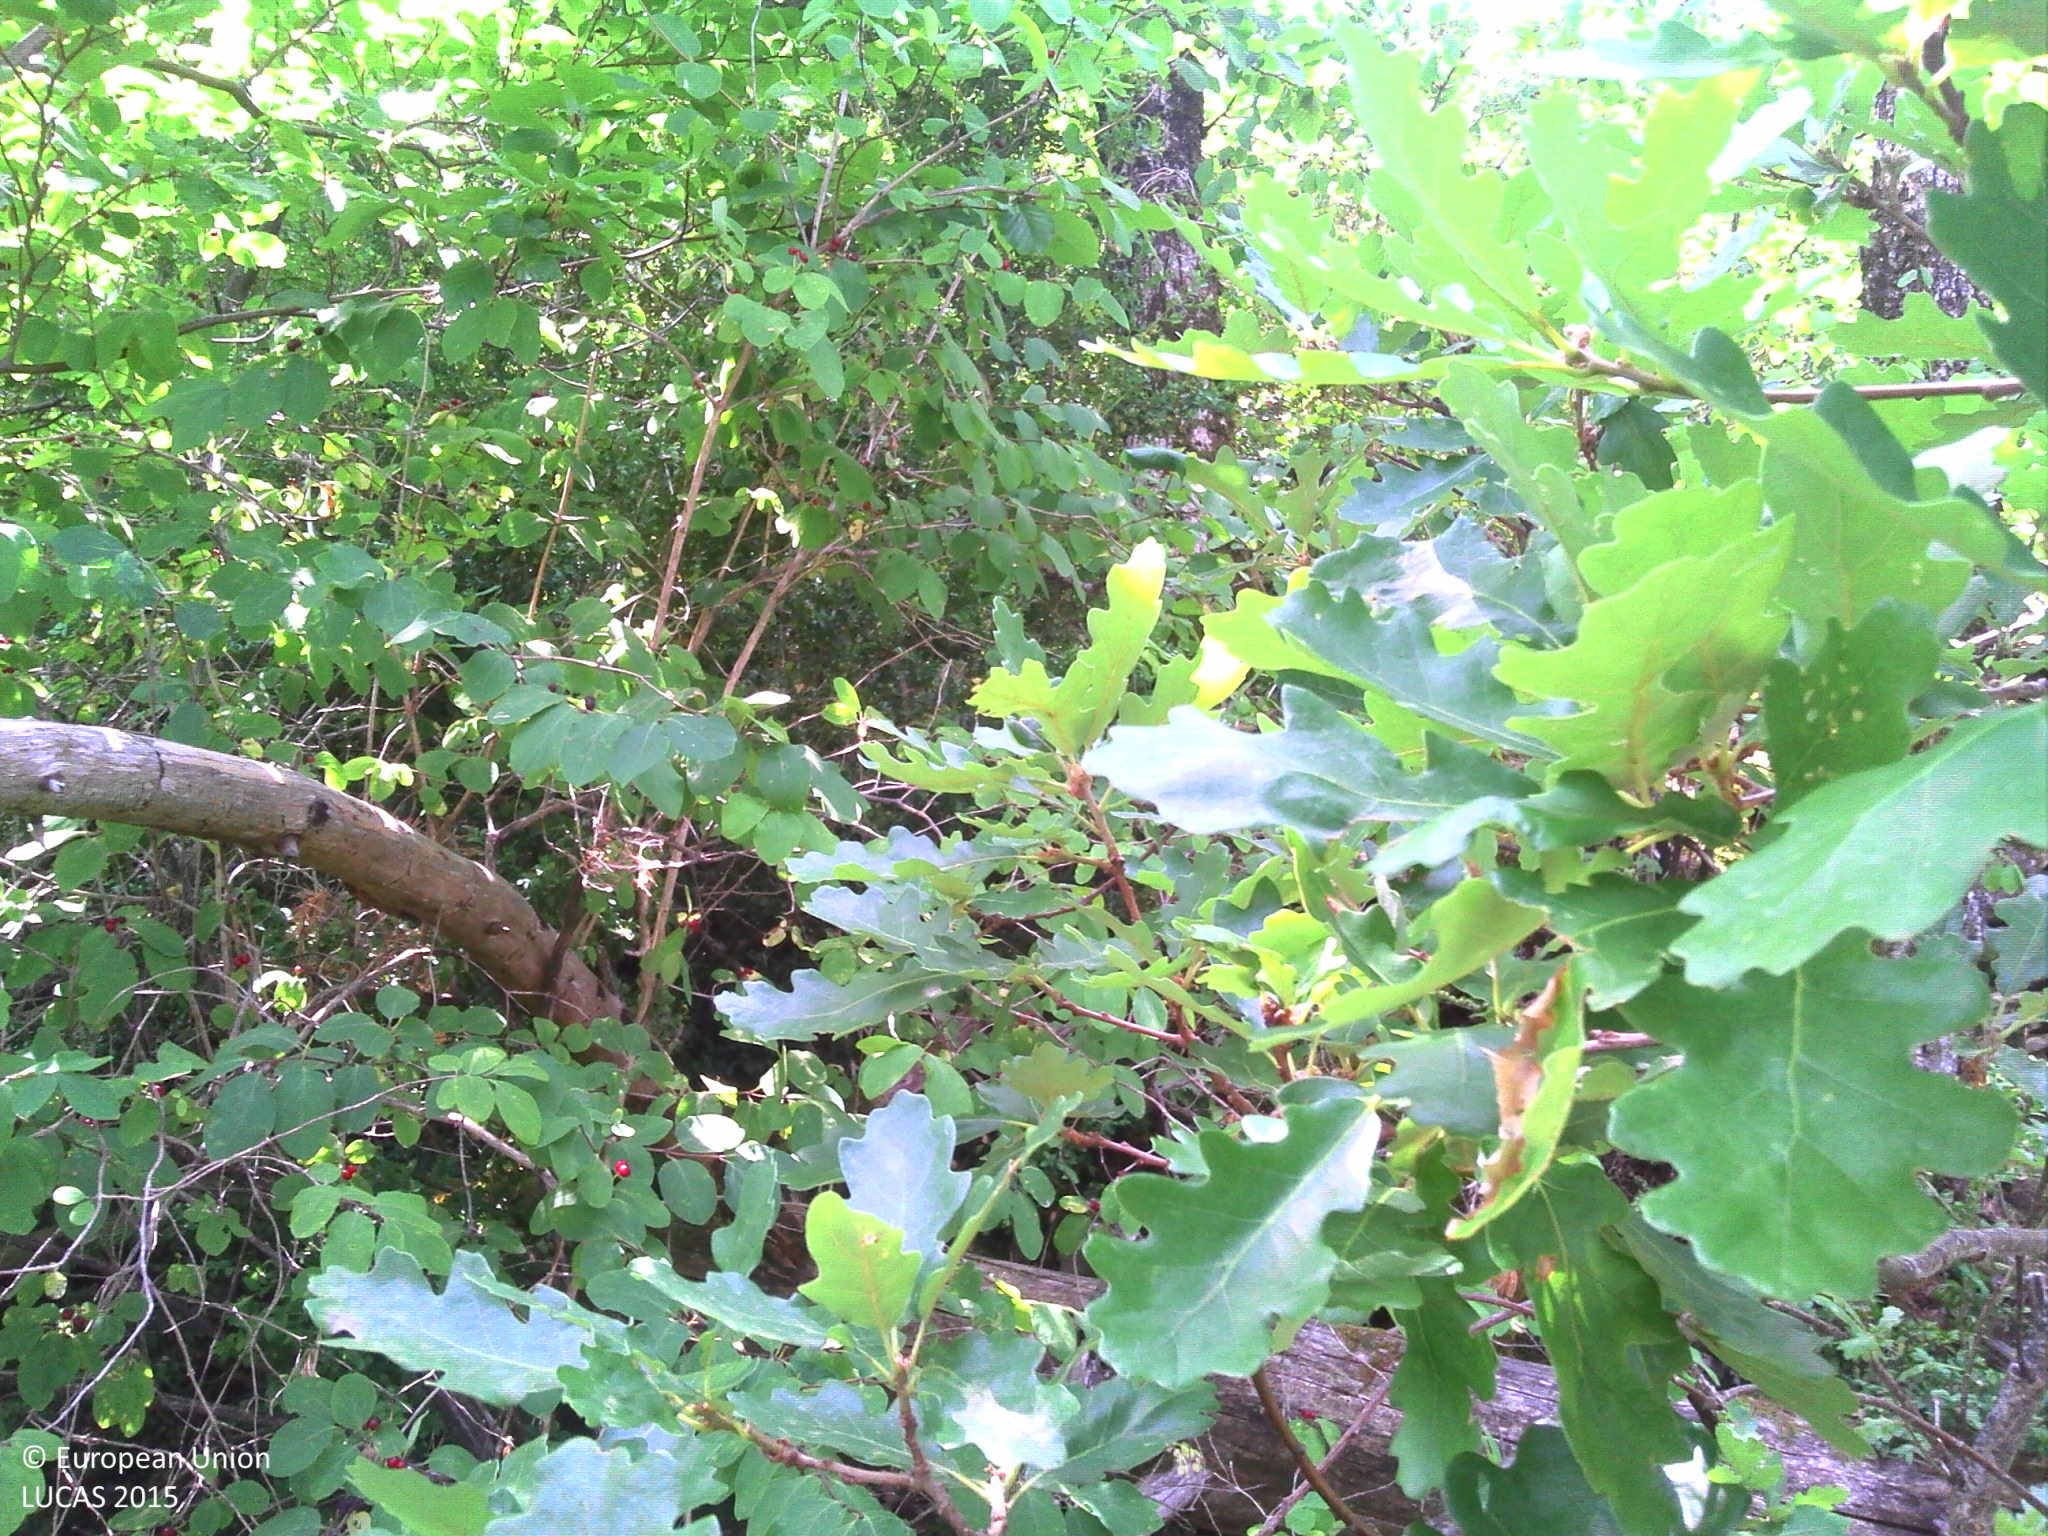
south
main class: Woodland
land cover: Pine dominated mixed woodland
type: hemiboreal forest and nemoral coniferous forest and mixed broadleaved-coniferous forest
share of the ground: > 75 %
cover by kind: broadleaved forest trees 75 %, coniferous forest trees 25 %
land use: Forestry
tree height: > 5 m
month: July
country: FR
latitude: 44.5285
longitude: 3.2475
